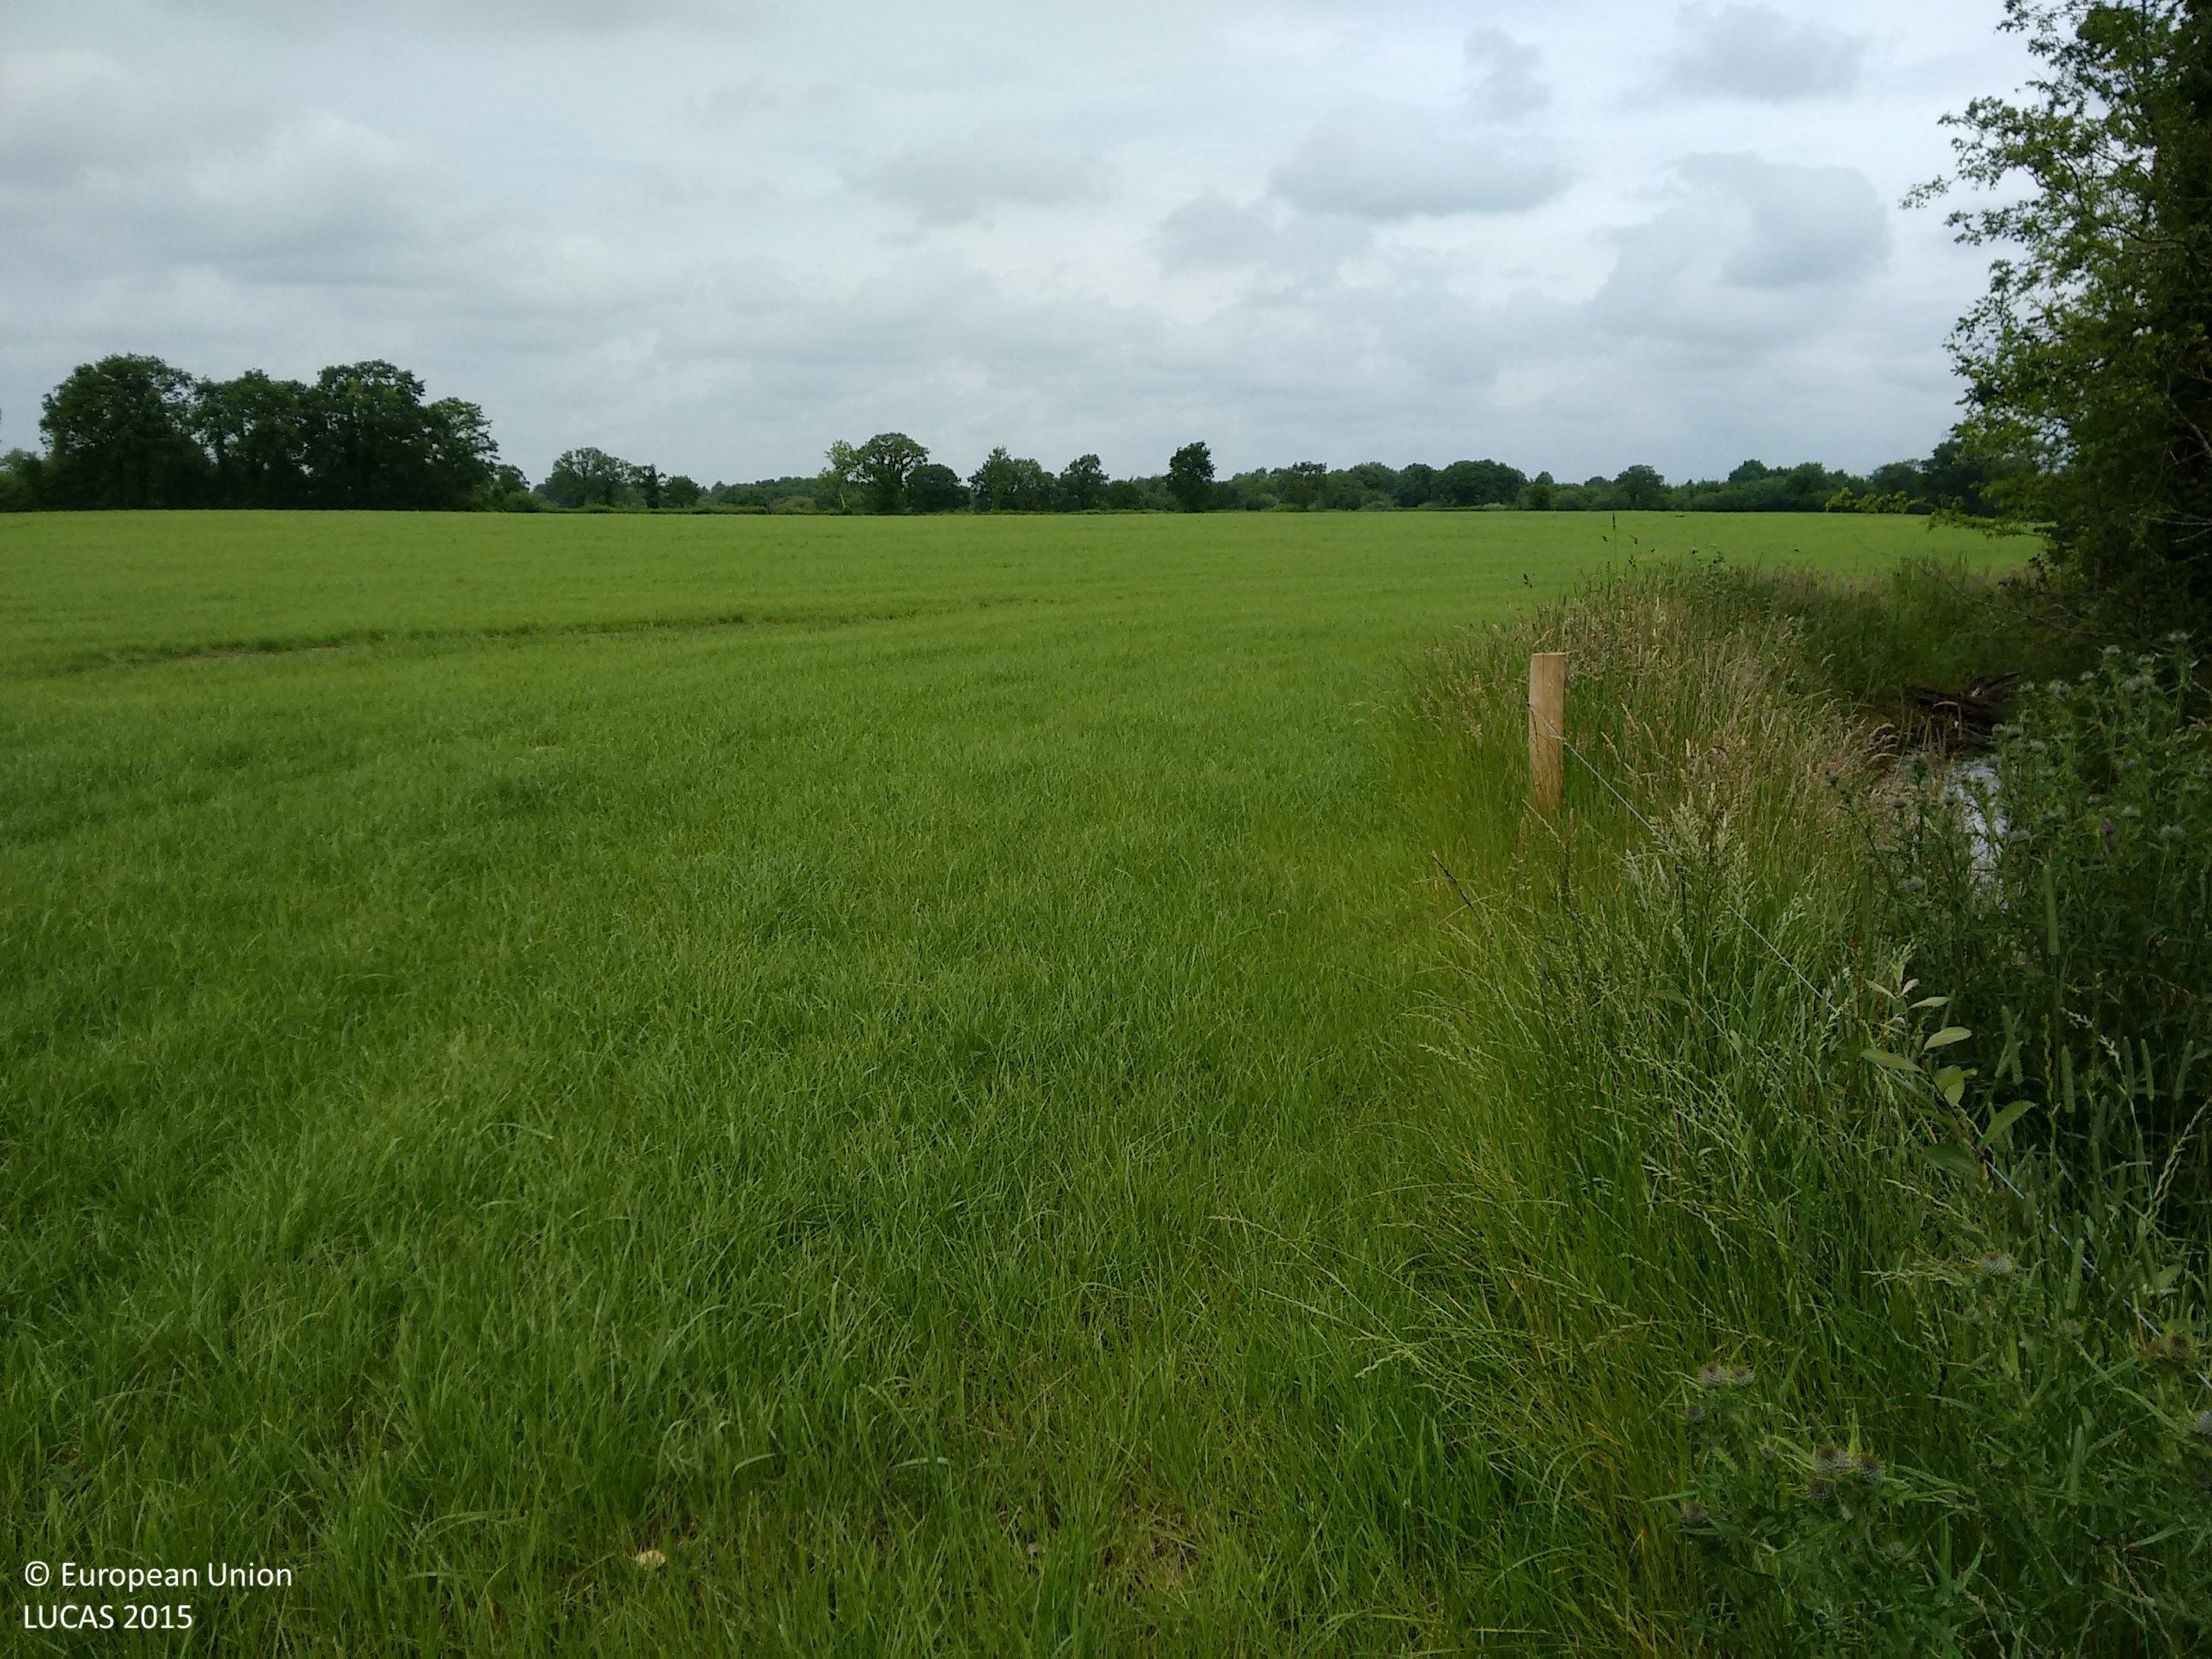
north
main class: Grassland
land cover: Grassland without tree/shrub cover
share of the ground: > 75 %
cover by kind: herbaceous plants 100 %
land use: Agriculture (excluding fallow land and kitchen gardens)
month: July
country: IE
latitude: 52.4912
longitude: -7.4325
